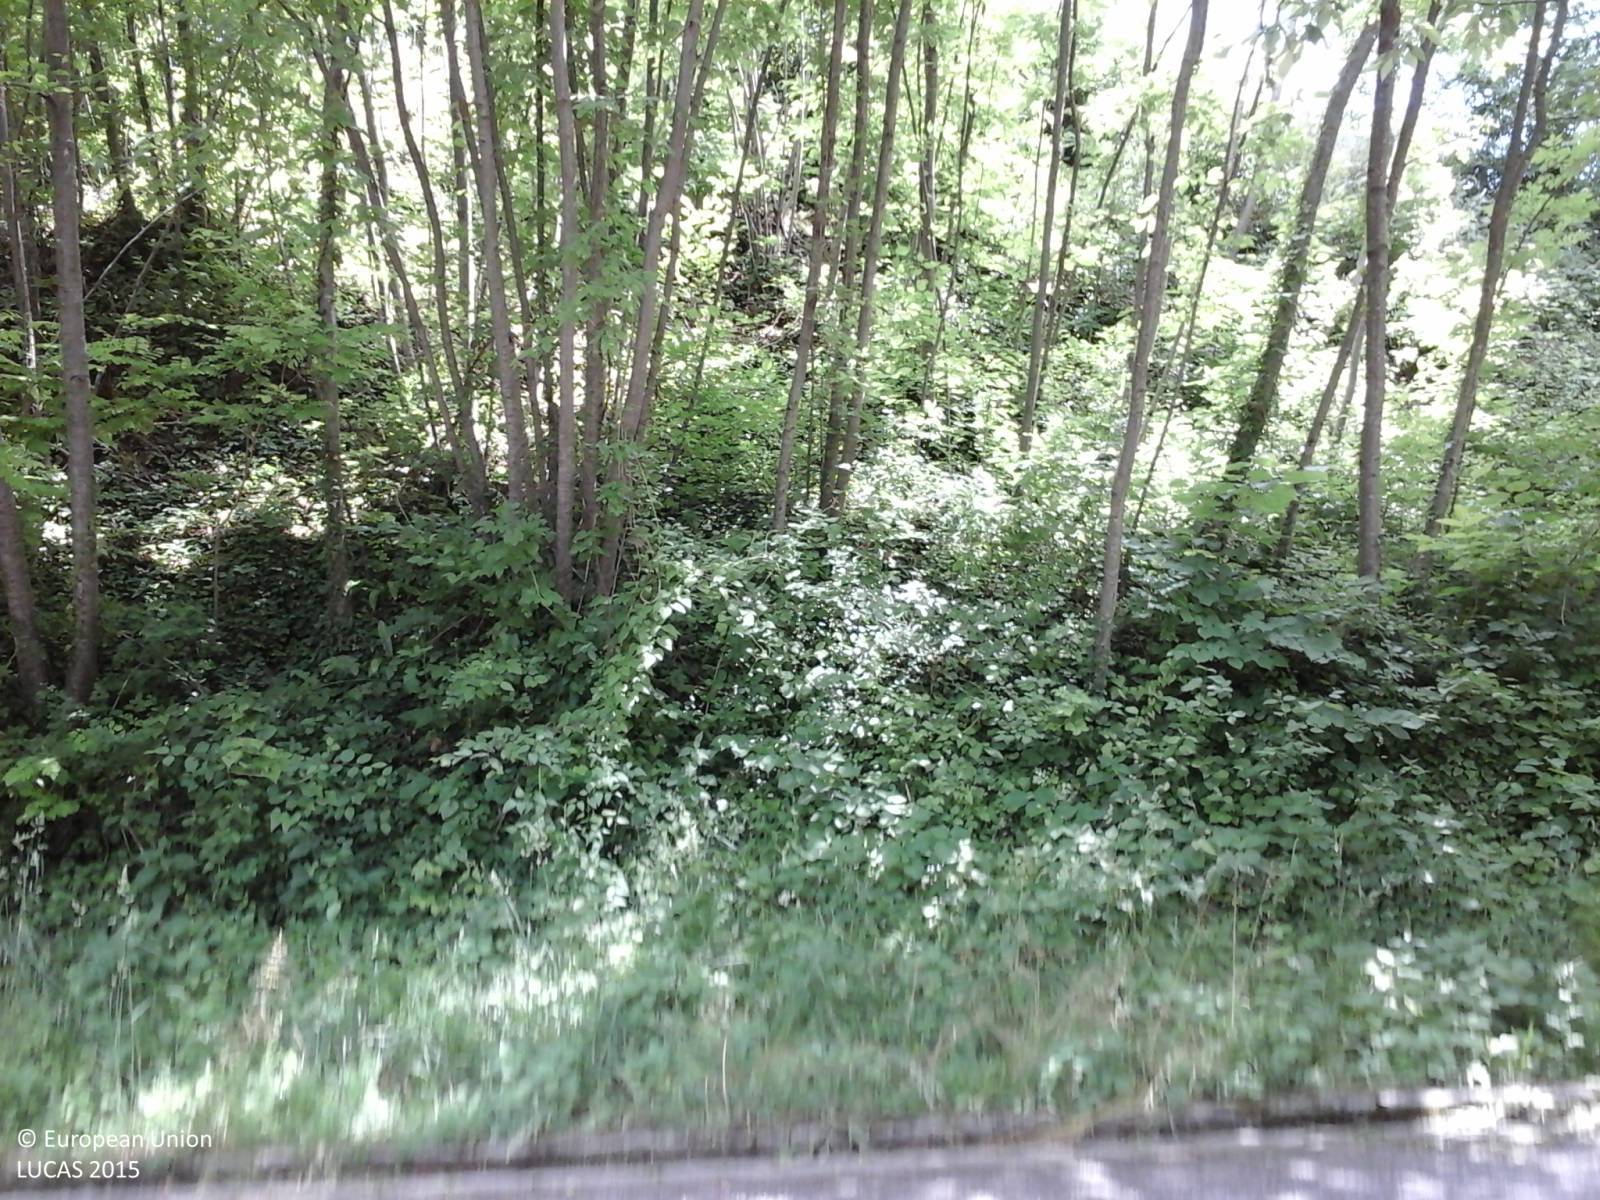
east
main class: Woodland
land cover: Broadleaved woodland
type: thermophilous deciduous forest
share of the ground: > 75 %
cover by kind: broadleaved forest trees 95 %, shrubs 5 %
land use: Forestry
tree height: > 5 m
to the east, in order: Broadleaved woodland; Paved roads, cycling and walking lanes; Grass margins; Broadleaved woodland; Olive groves; Shrubland with sparse tree cover; Maize; Artificial constructions in urban areas; Broadleaved woodland; Ditches and canals
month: May
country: IT
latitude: 46.2305
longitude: 13.2253
